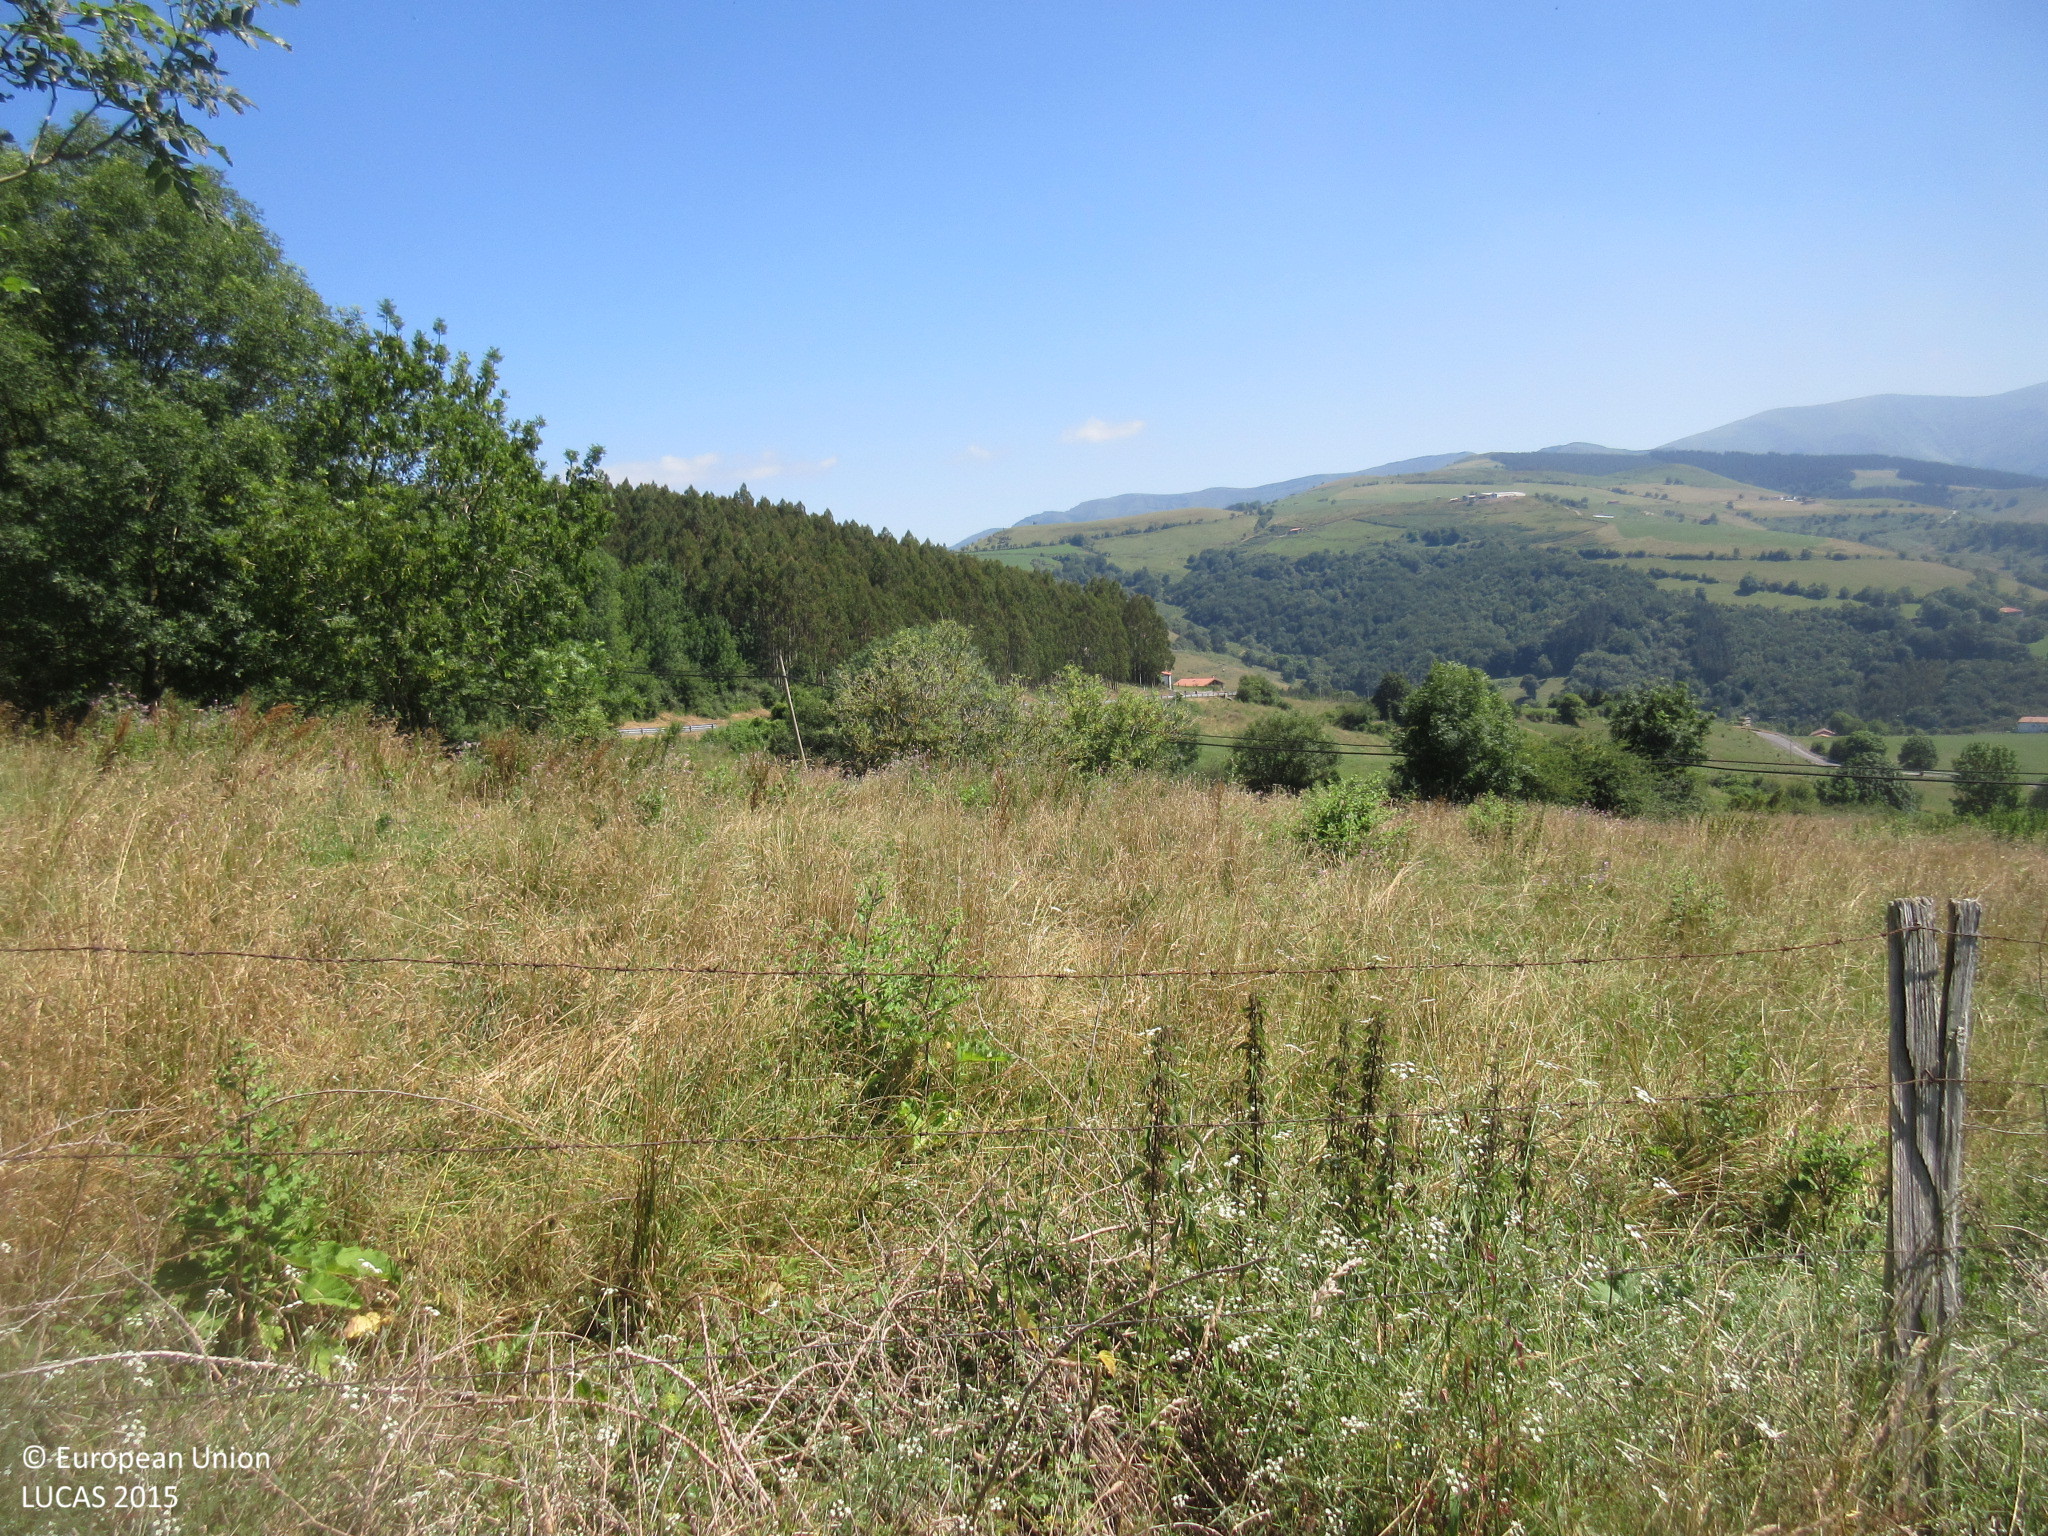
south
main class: Grassland
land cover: Grassland without tree/shrub cover
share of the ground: > 75 %
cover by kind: herbaceous plants 100 %
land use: Agriculture (excluding fallow land and kitchen gardens)
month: July
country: ES
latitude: 43.2183
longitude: -3.4222
